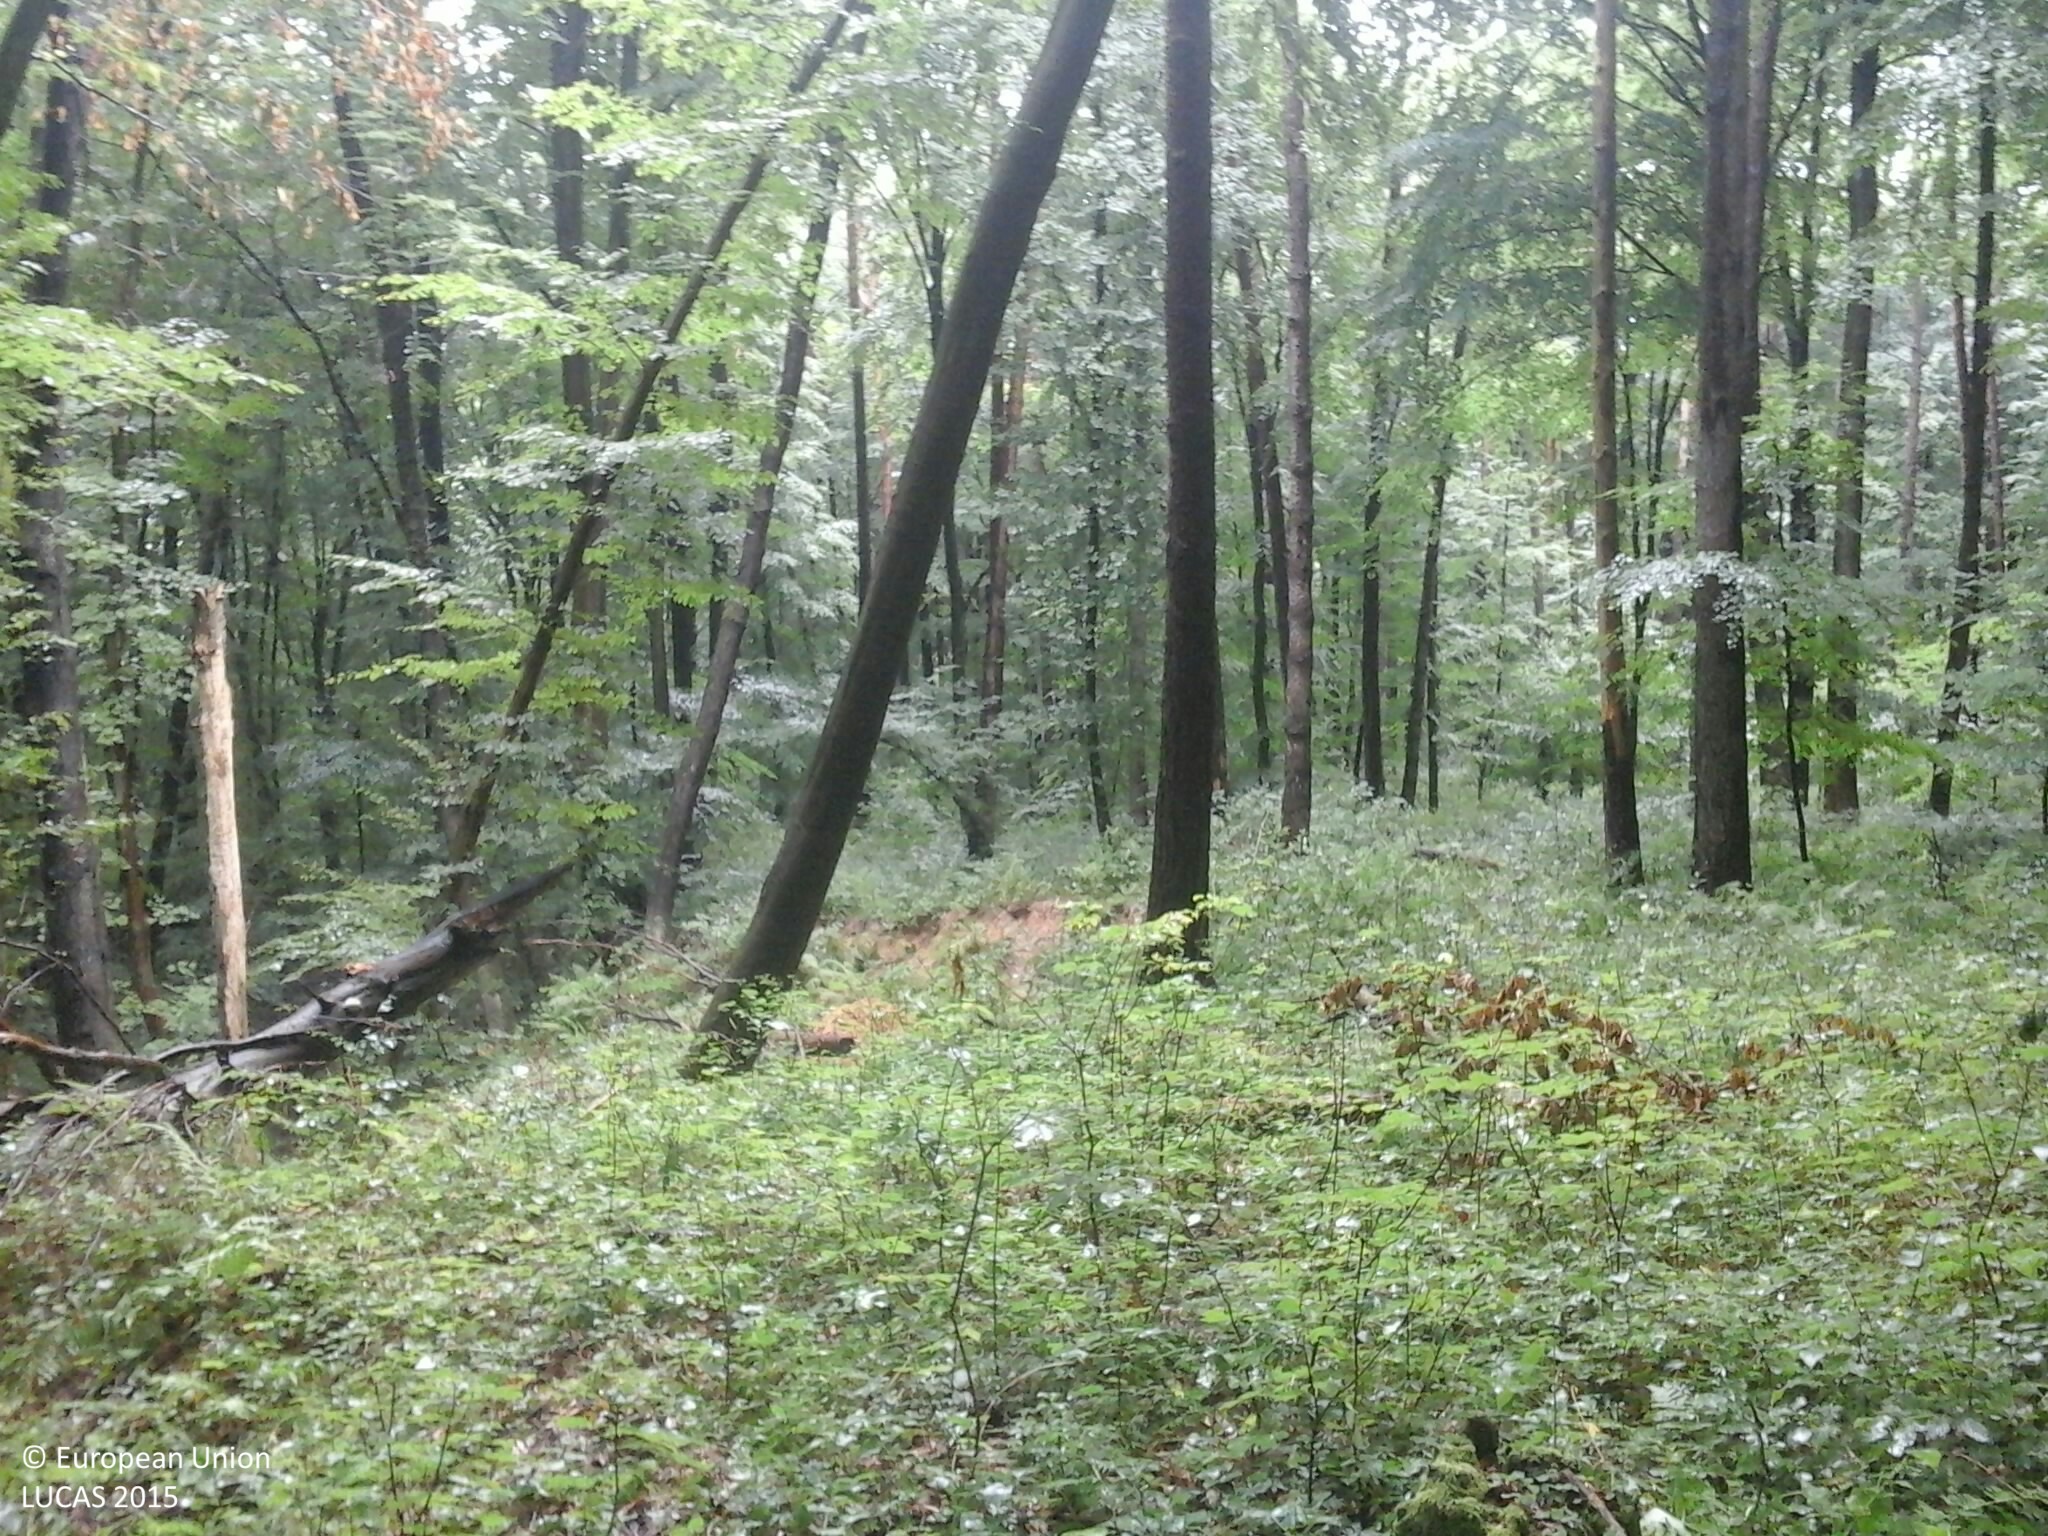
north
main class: Woodland
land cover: Broadleaved woodland
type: beech forest
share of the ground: > 75 %
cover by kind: broadleaved forest trees 80 %, shrubs 10 %, herbaceous plants 10 %
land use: Forestry
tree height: > 5 m
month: July
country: HU
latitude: 46.5862
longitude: 16.5138
